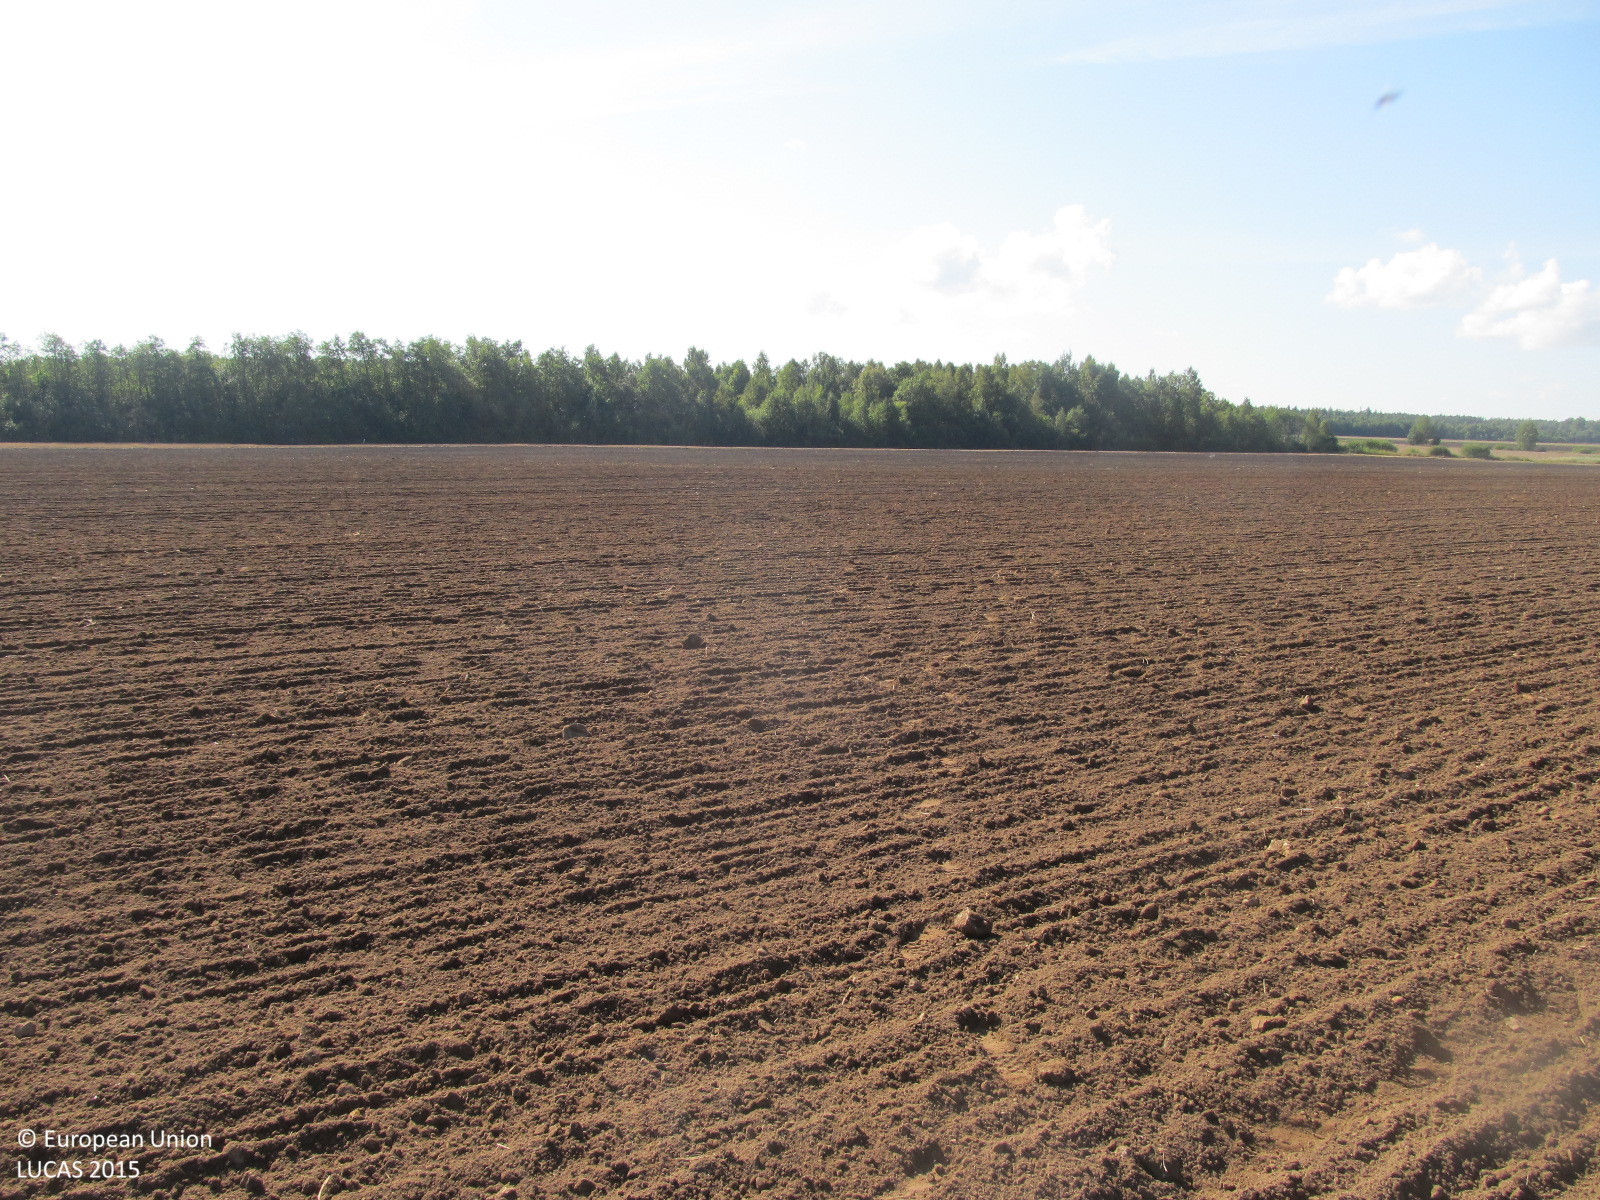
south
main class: Cropland
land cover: Common wheat
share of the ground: > 75 %
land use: Agriculture (excluding fallow land and kitchen gardens)
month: September
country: LT
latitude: 56.1471
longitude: 22.9594
